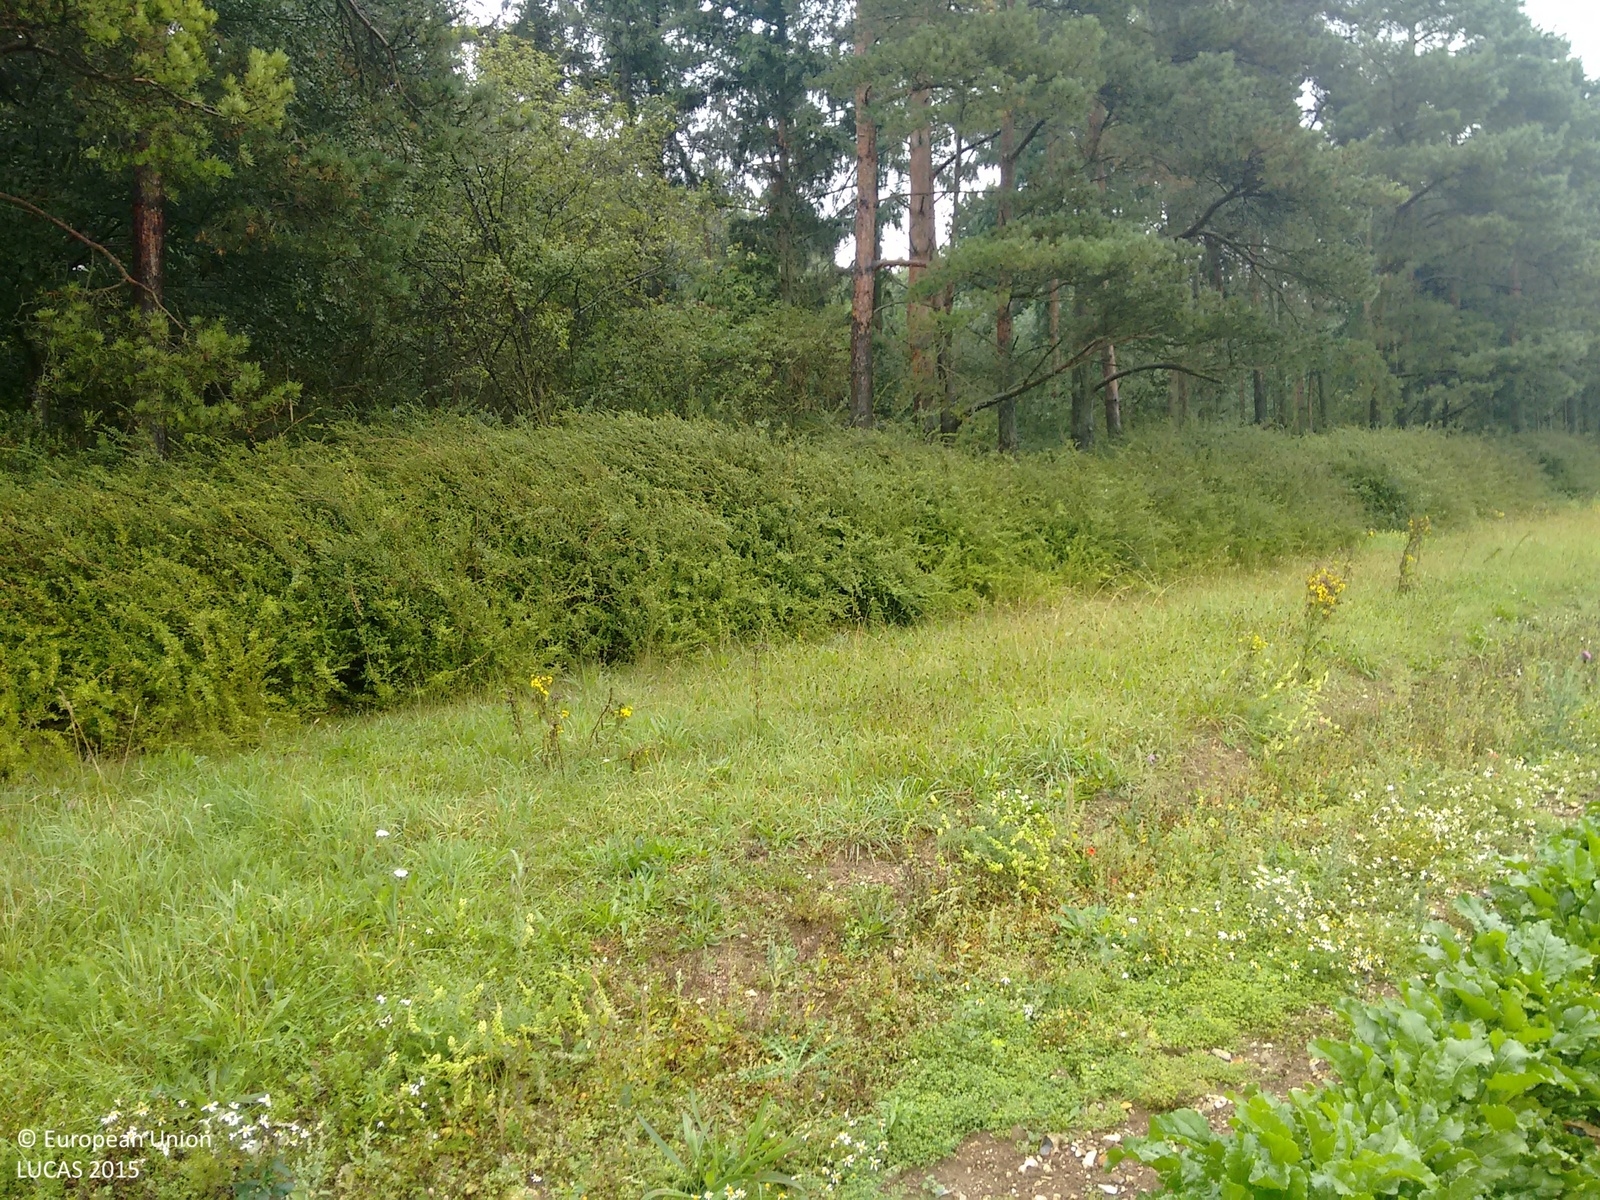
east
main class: Cropland
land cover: Sugar beet
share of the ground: > 75 %
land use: Agriculture (excluding fallow land and kitchen gardens)
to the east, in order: Sugar beet; Grass margins; Managed hedges; Pine dominated mixed woodland; Maize; Sugar beet
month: September
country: GB
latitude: 52.2192
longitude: 0.3540
